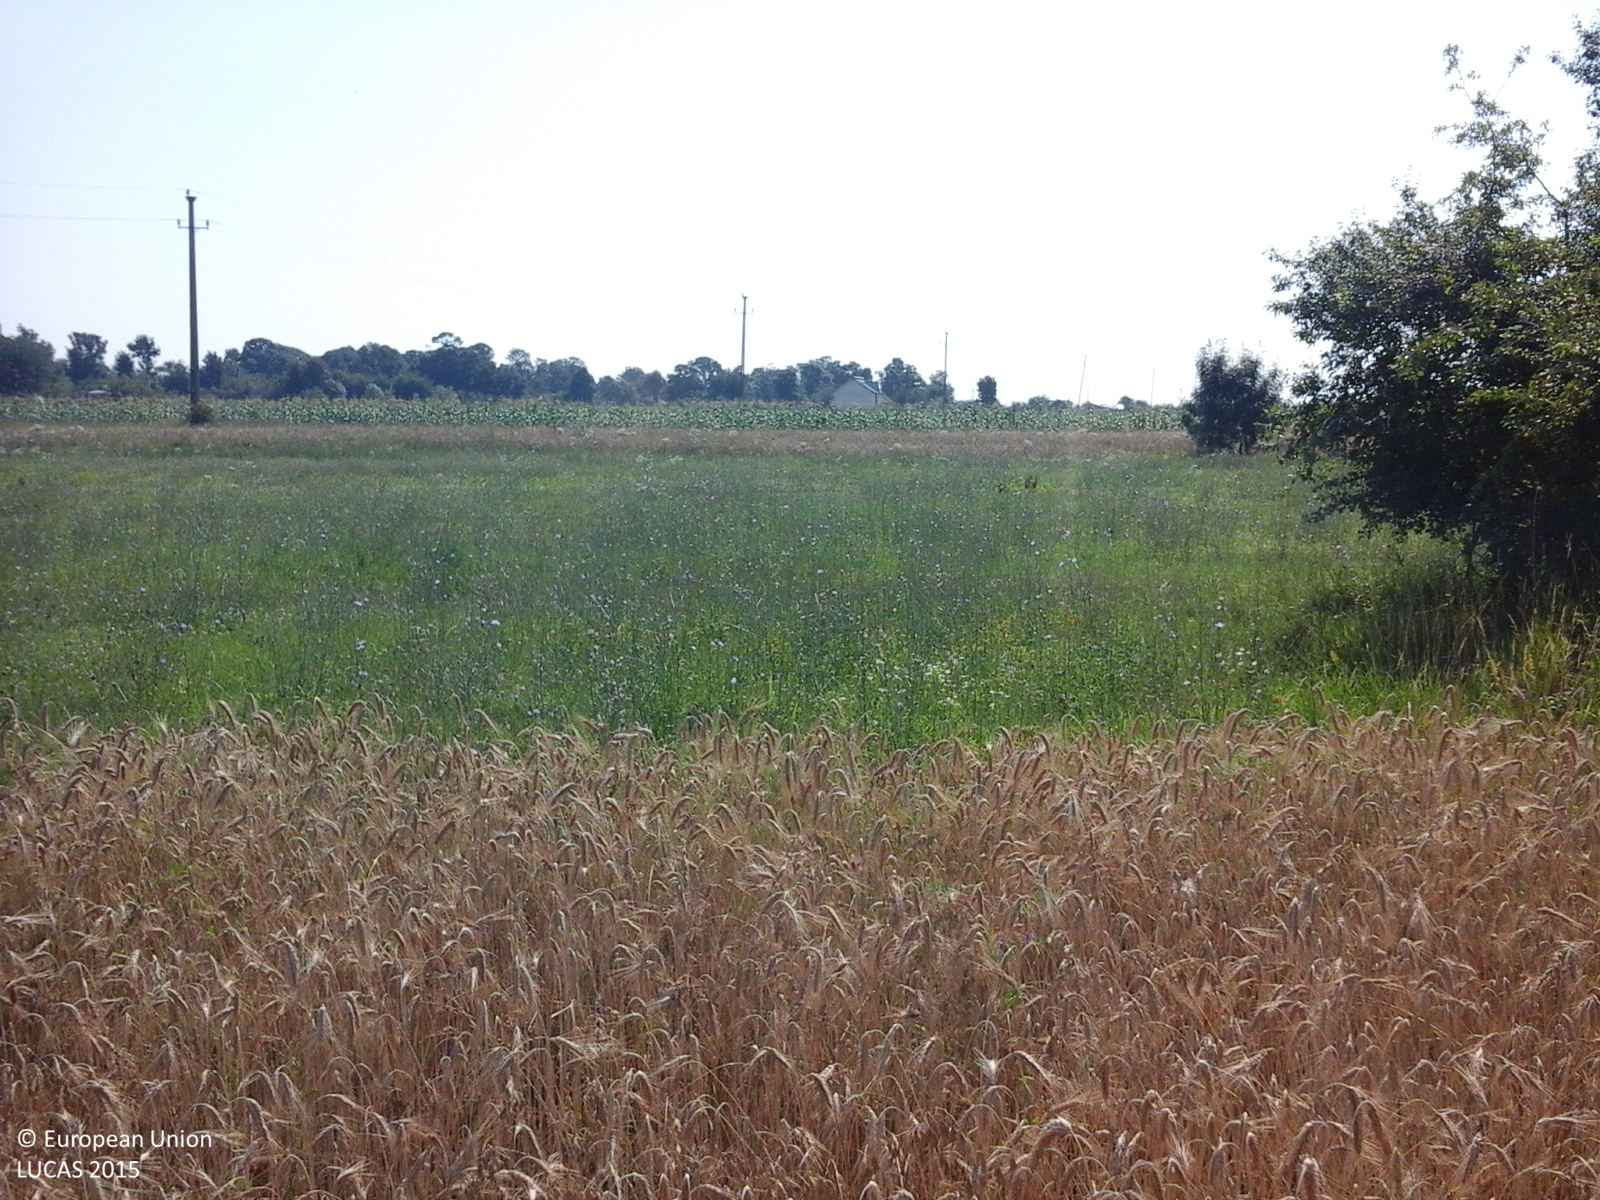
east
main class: Cropland
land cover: Common wheat
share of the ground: > 75 %
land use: Agriculture (excluding fallow land and kitchen gardens)
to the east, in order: Common wheat; Lucerne; Common wheat; Maize; Lucerne; Grassland without tree/shrub cover; Common wheat; Maize; Lucerne; Electric lines; Lucerne; Maize; Grassland without tree/shrub cover
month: July
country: RO
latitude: 44.4904
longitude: 24.9305
